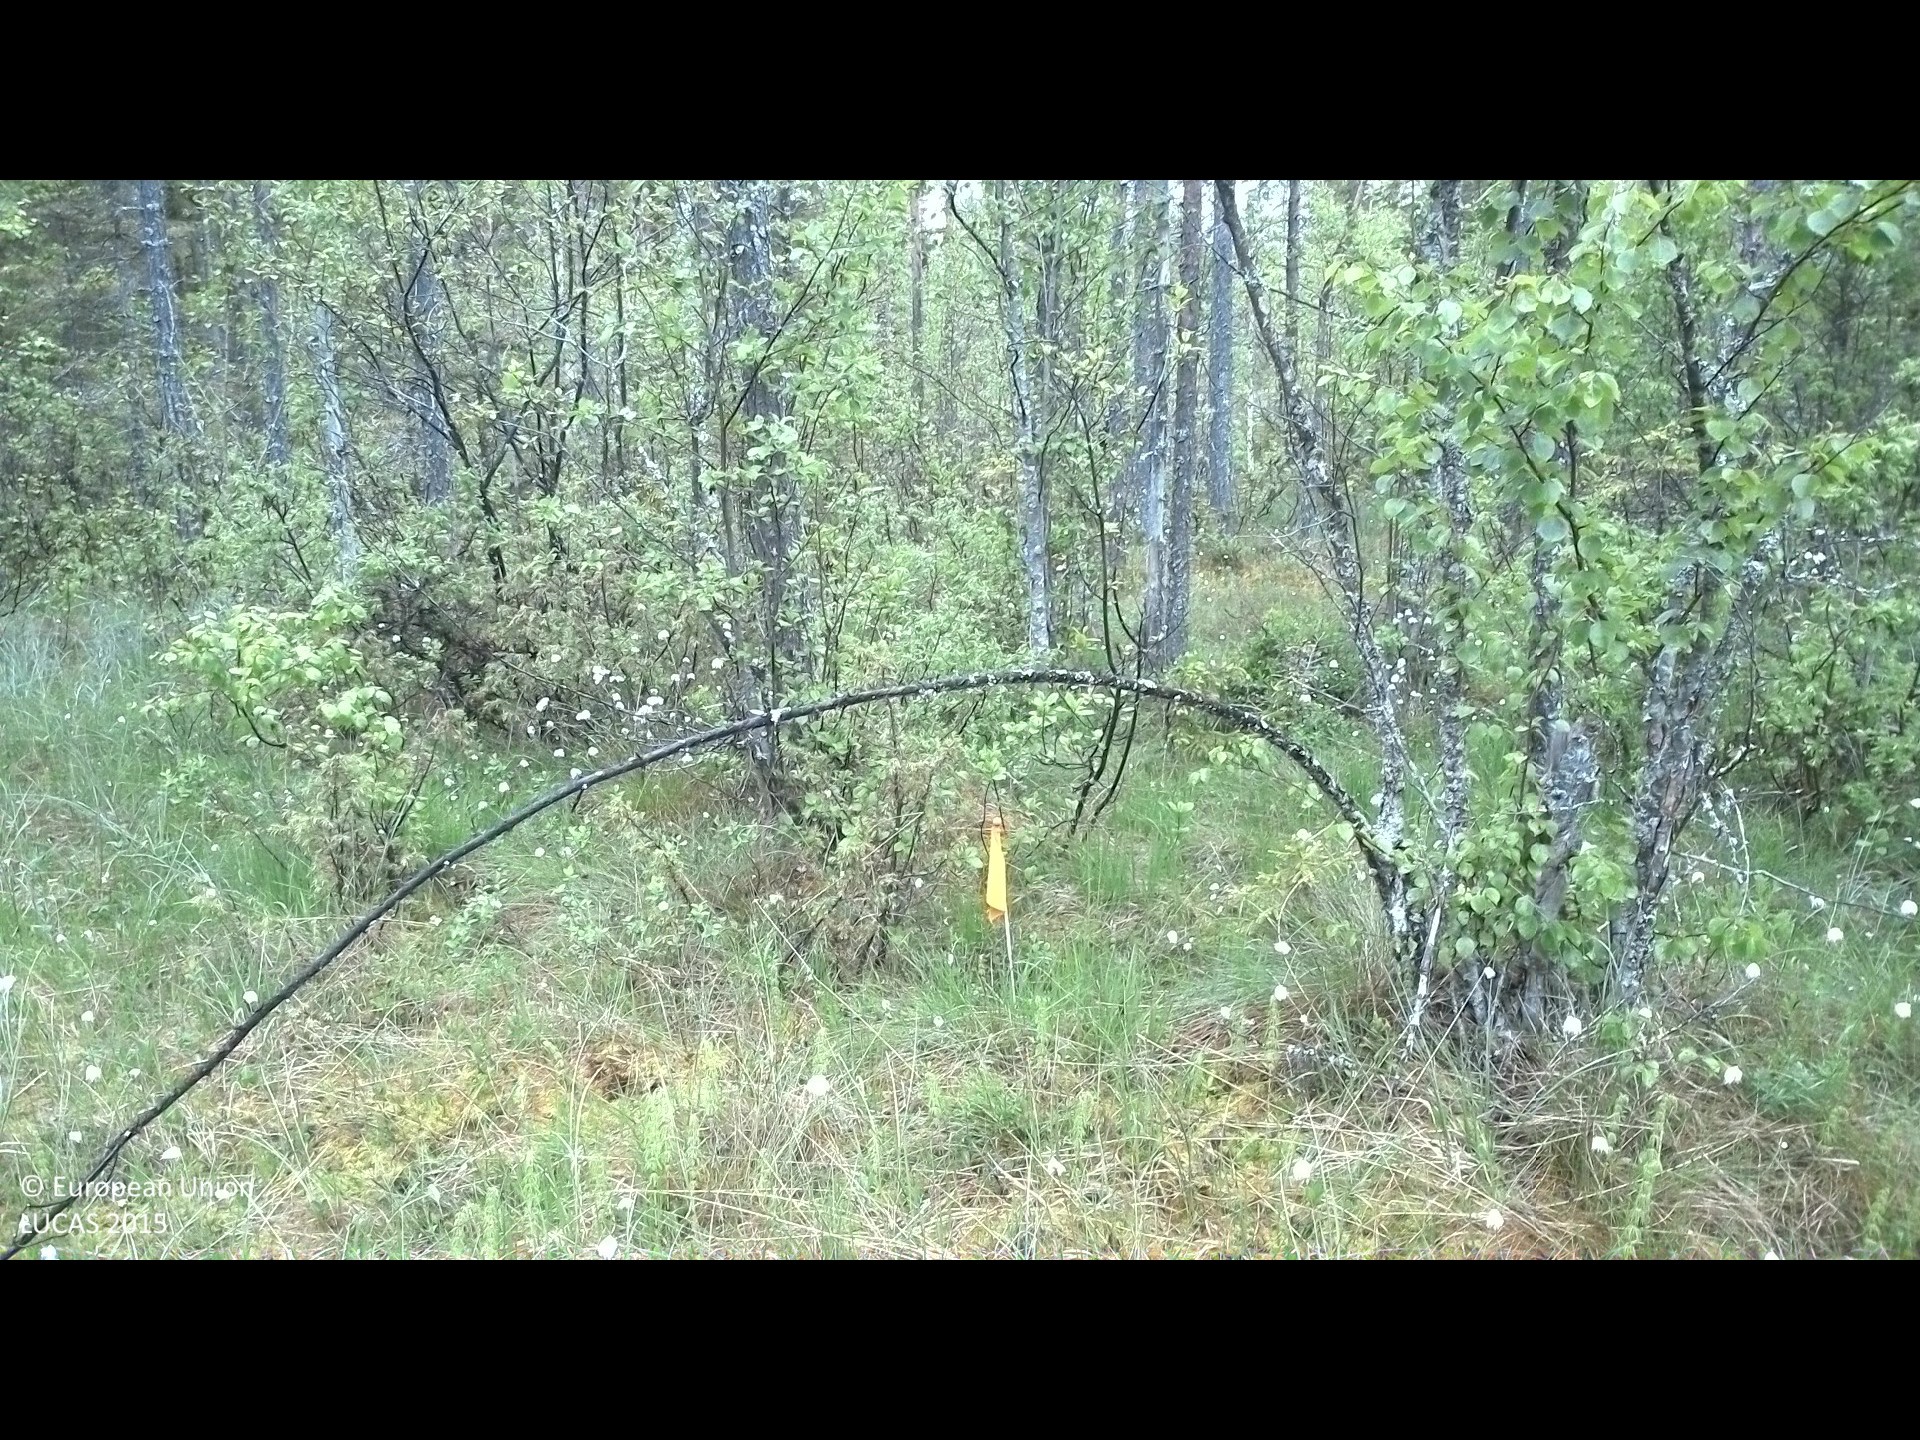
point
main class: Woodland
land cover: Pine dominated mixed woodland
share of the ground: 10 - 25 %
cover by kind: lichens and mosses 50 %, shrubs 25 %, coniferous forest trees 10 %, herbaceous plants 10 %, broadleaved forest trees 5 %
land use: Forestry
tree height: > 5 m
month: June
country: SE
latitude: 61.9186
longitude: 17.1239
